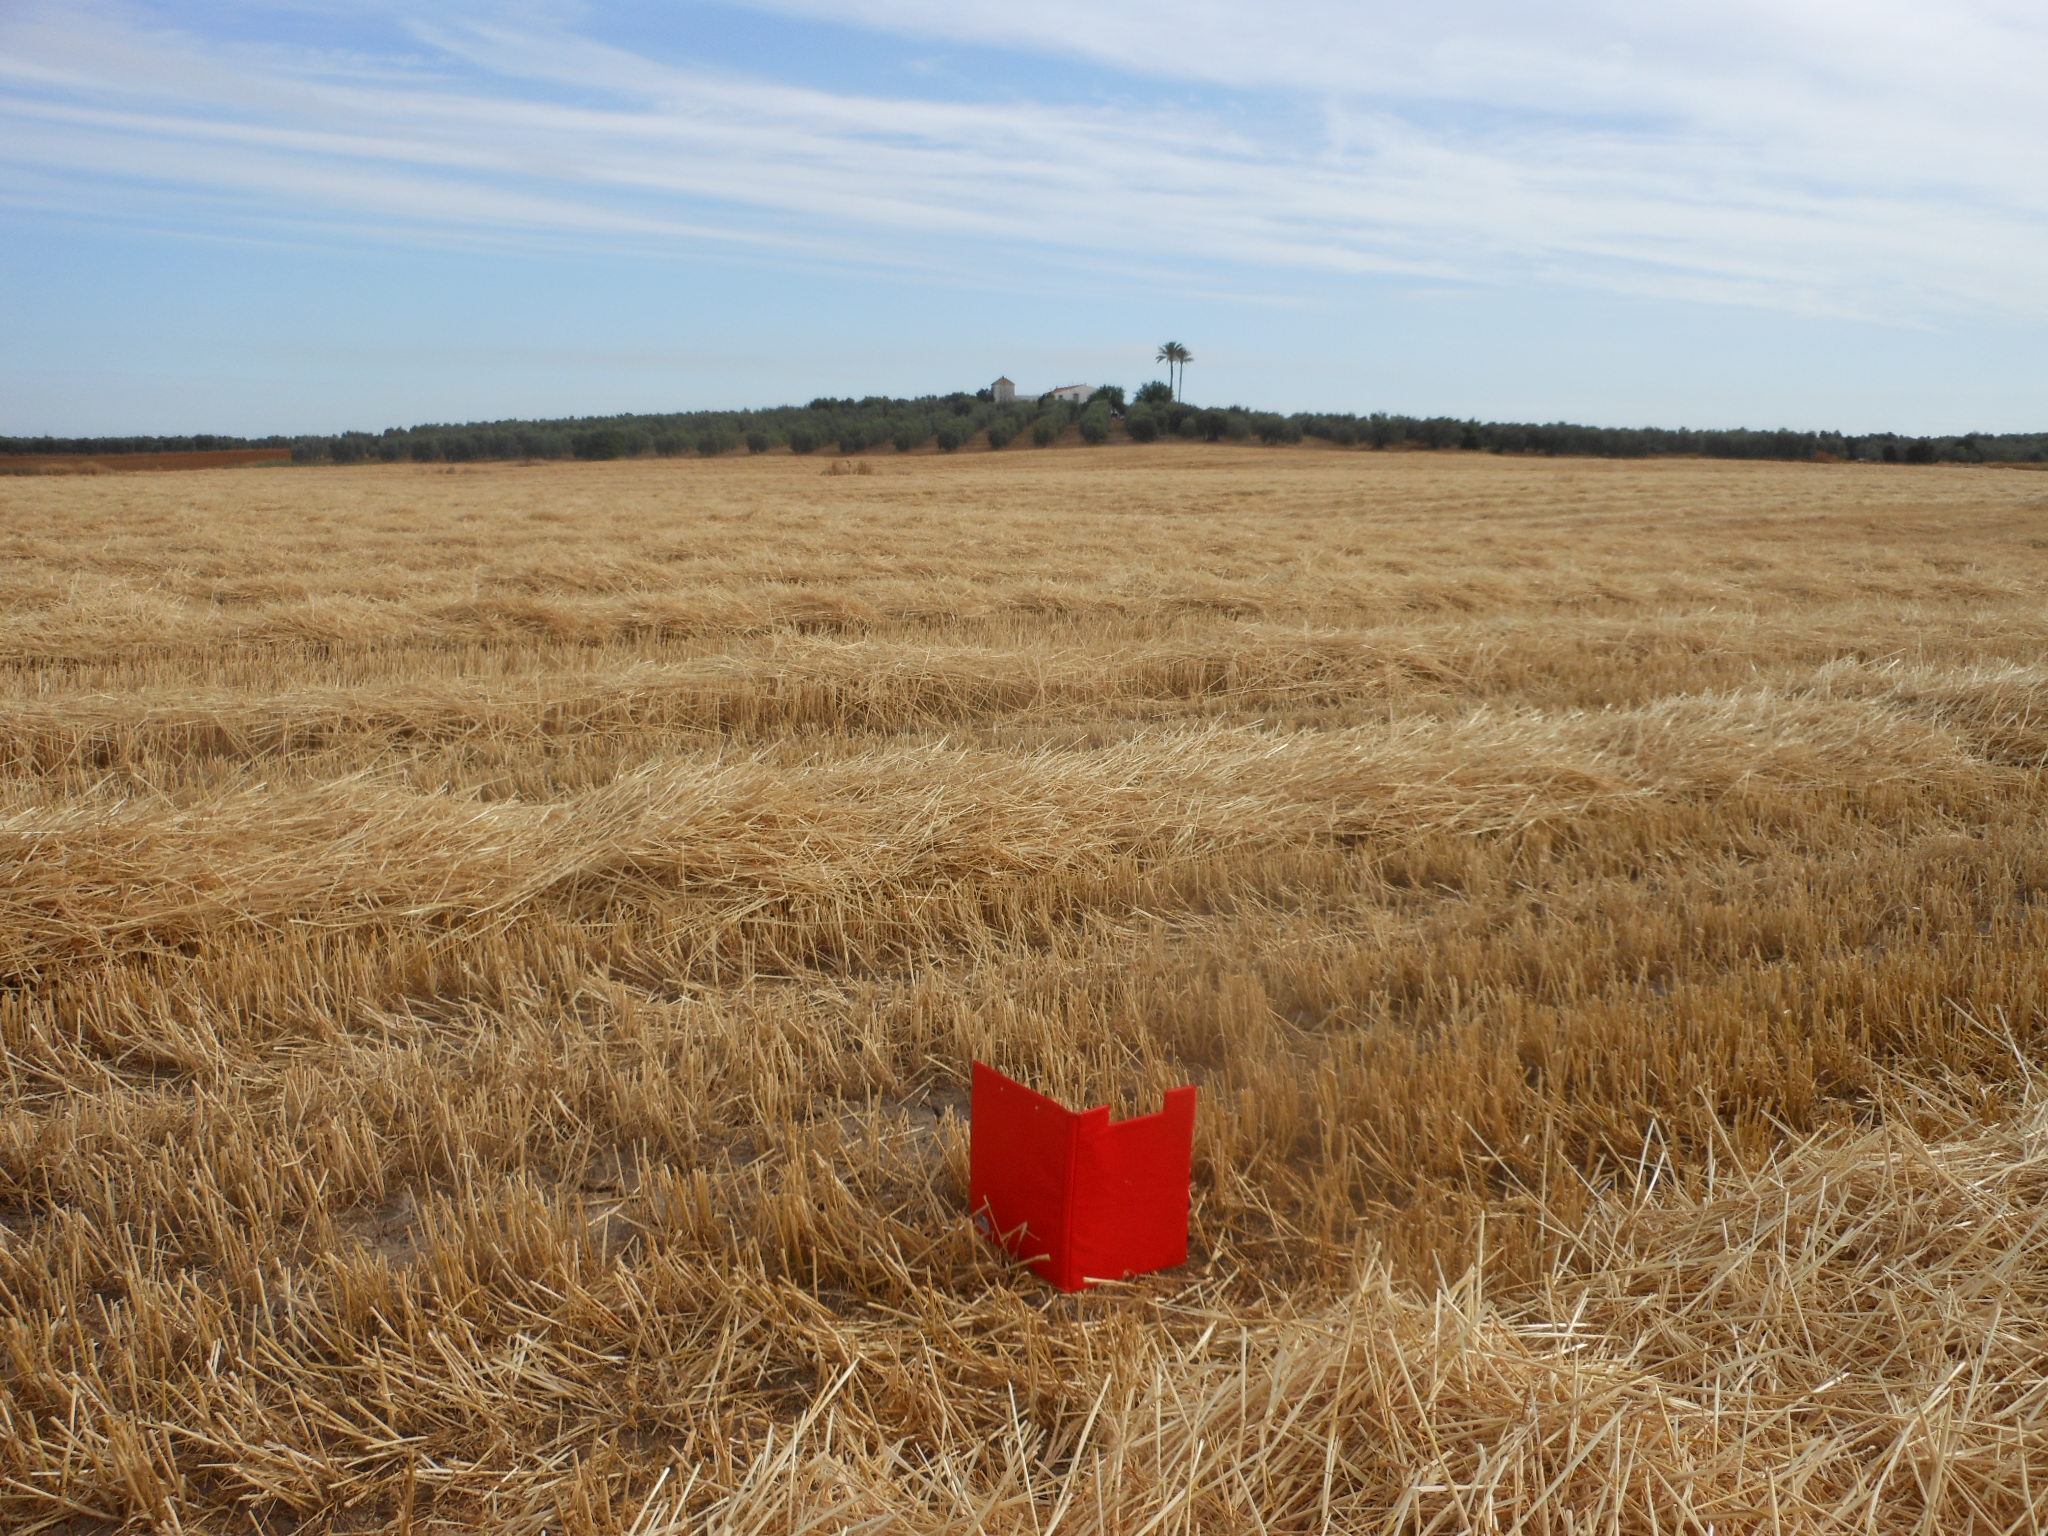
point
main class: Cropland
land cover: Common wheat
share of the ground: < 10 %
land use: Agriculture (excluding fallow land and kitchen gardens)
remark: Harvested field
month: June
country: ES
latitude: 37.1939
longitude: -5.4570
